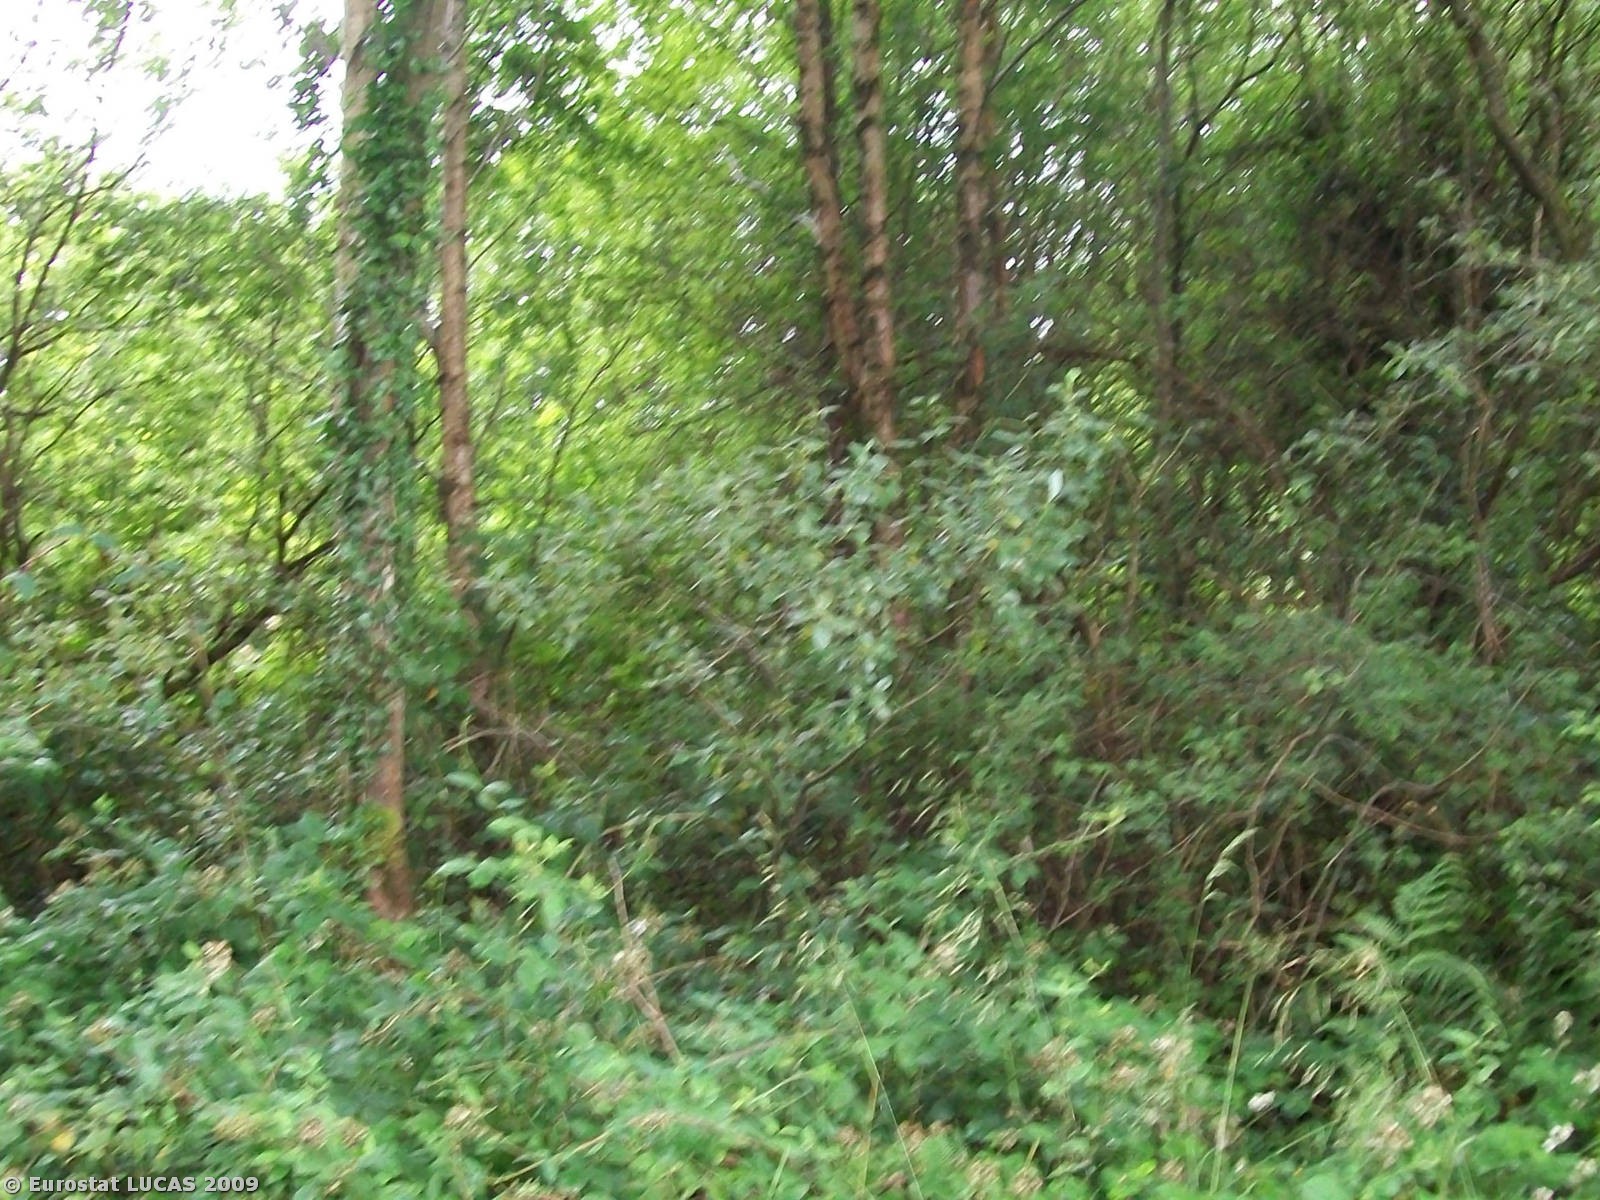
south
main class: Grassland
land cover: Grassland without tree/shrub cover
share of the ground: > 75 %
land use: Agriculture (excluding fallow land and kitchen gardens)
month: July
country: IE
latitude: 53.9705
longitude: -9.1041
